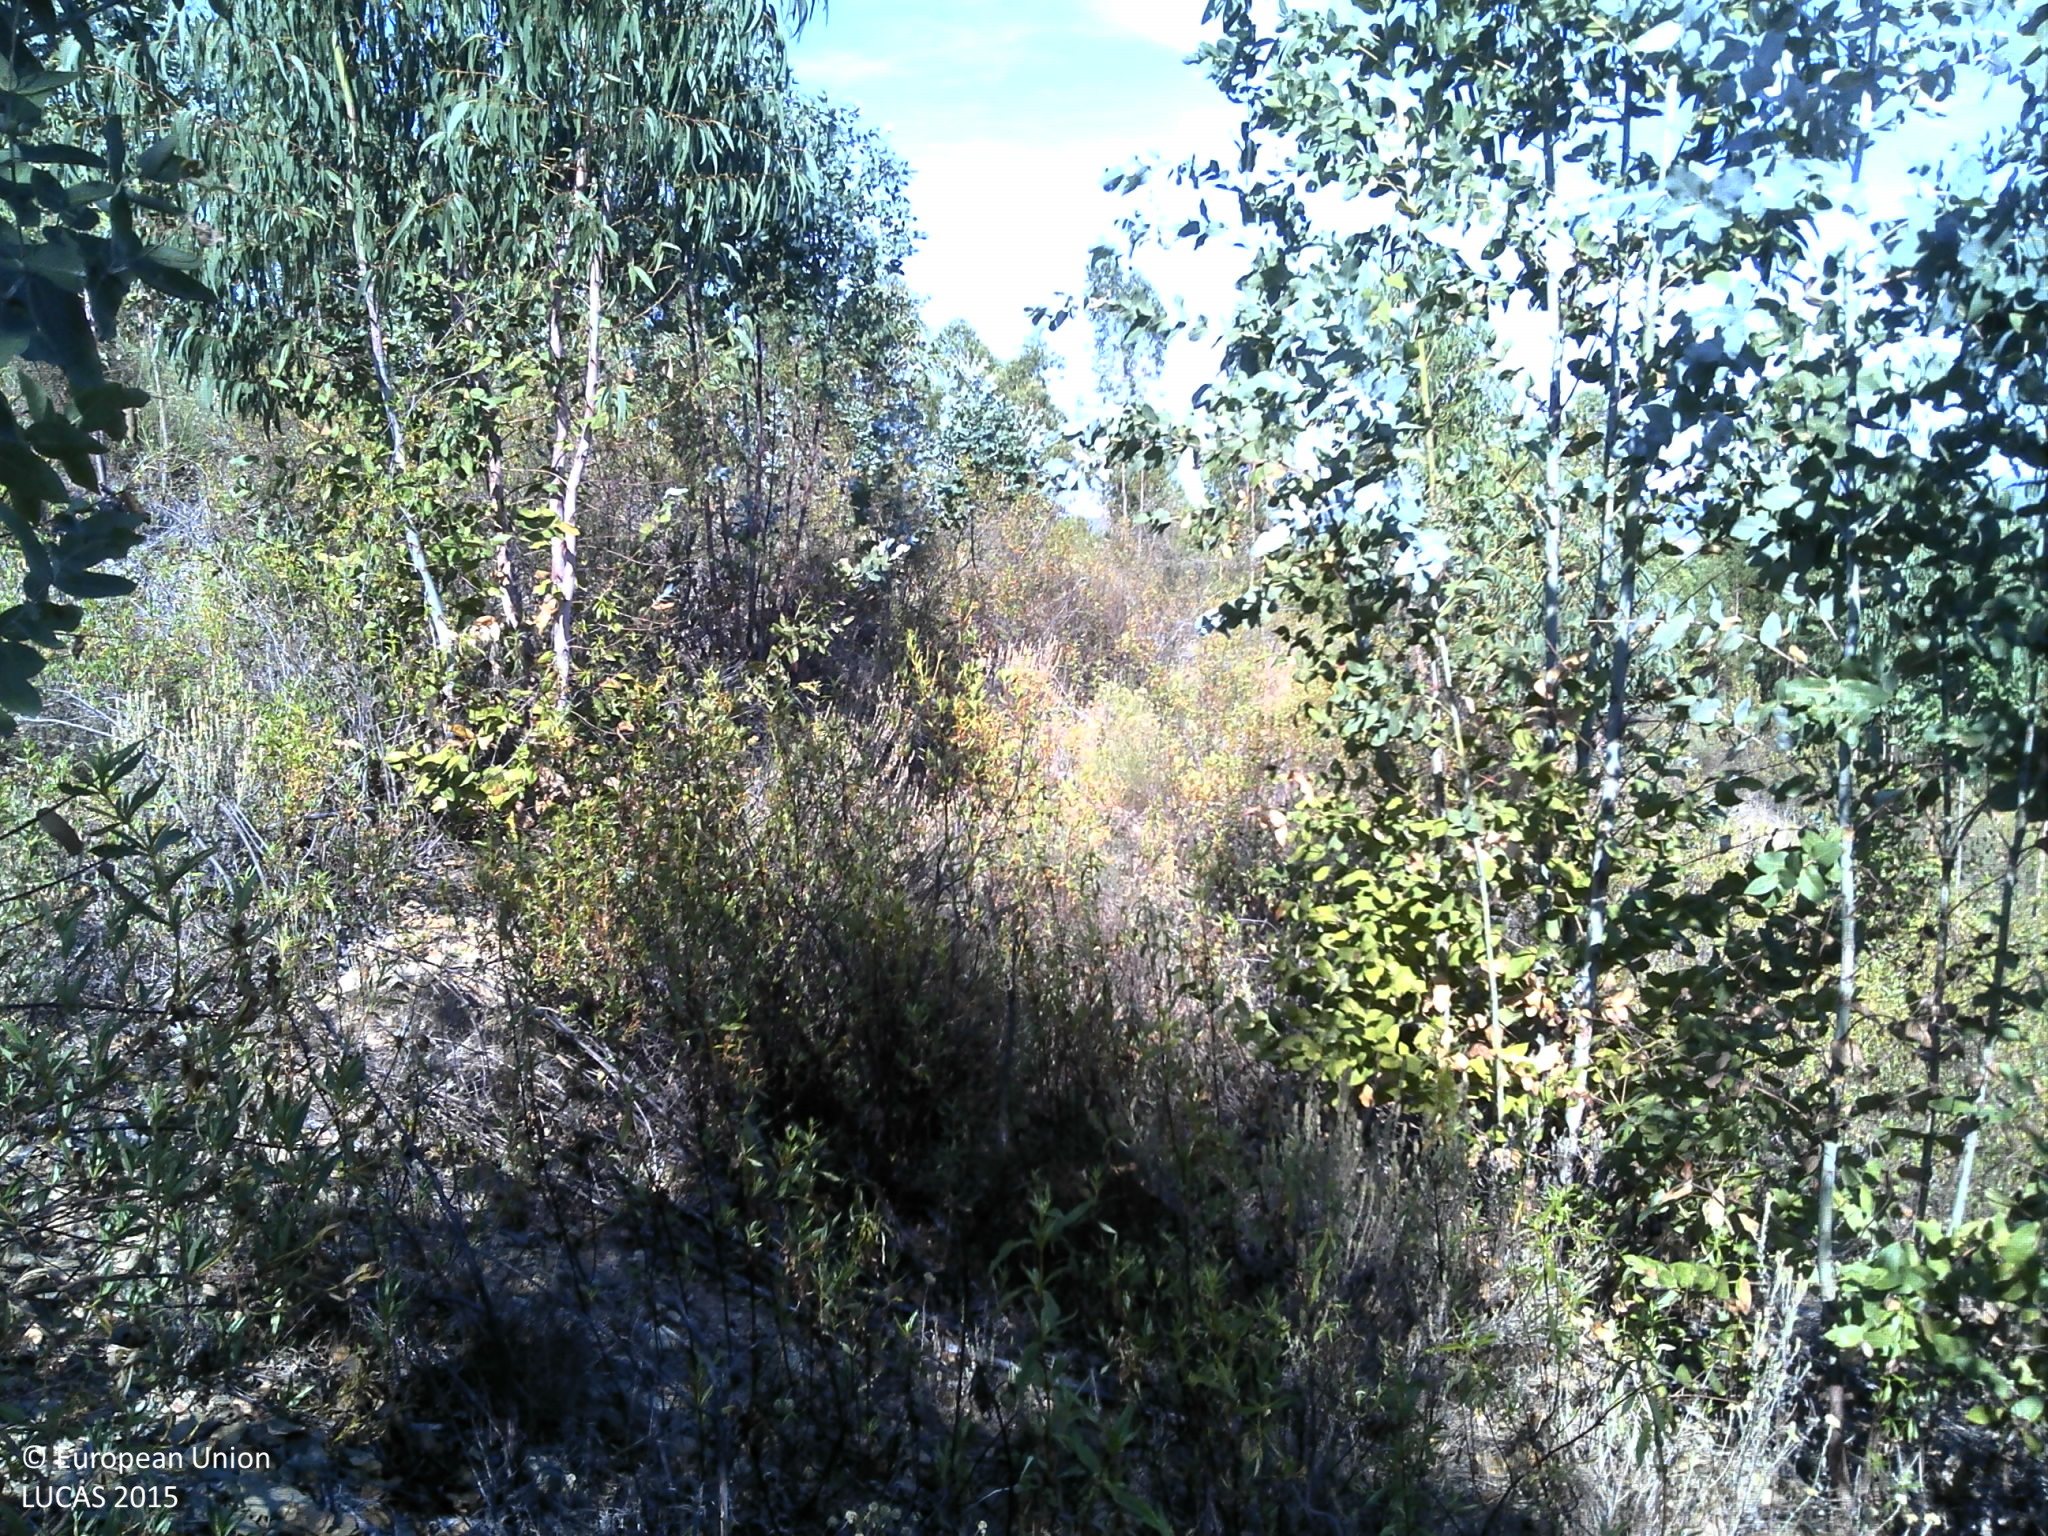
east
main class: Woodland
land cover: Broadleaved woodland
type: exotic forest
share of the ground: 10 - 25 %
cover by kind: shrubs 70 %, broadleaved forest trees 15 %, unconsolidated bare surface 15 %
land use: Forestry
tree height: > 5 m
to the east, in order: Broadleaved woodland; Other structural elements; Shrubland without tree cover; Broadleaved woodland; Tracks; Broadleaved woodland; Other structural elements; Dry stone walls; Shrubland with sparse tree cover
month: July
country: PT
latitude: 39.6135
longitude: -7.7480
